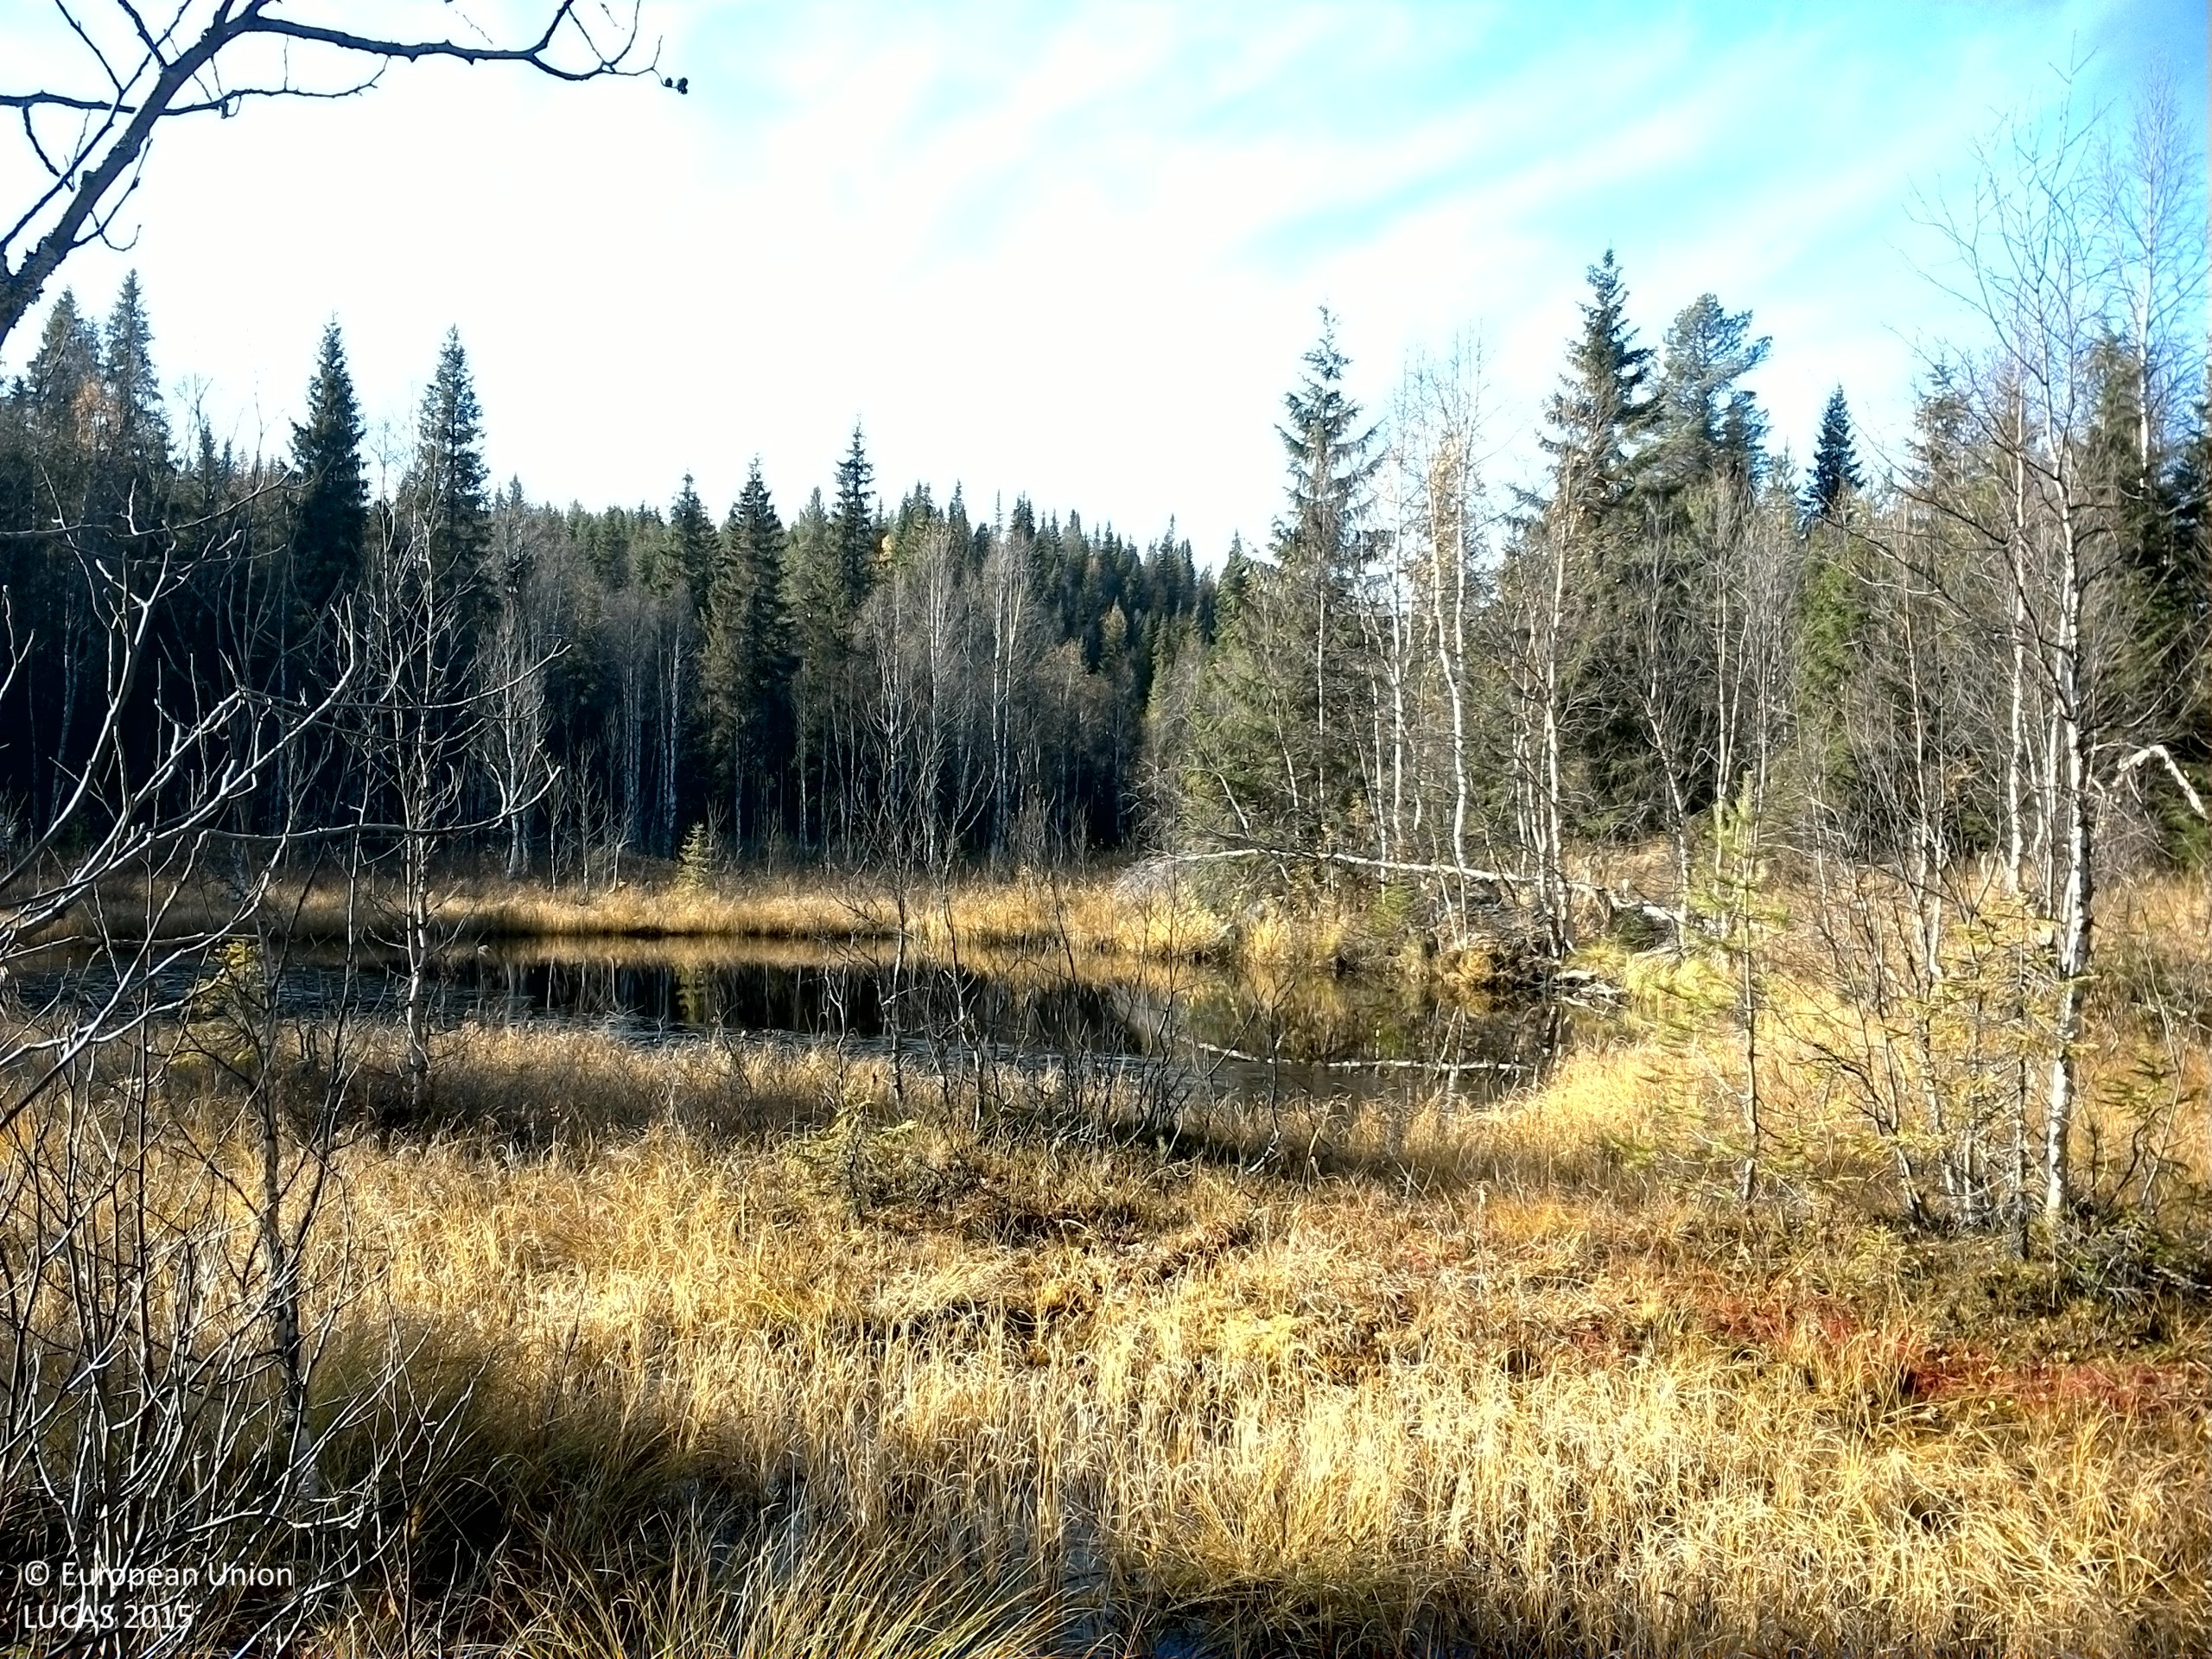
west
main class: Woodland
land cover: Spruce dominated mixed woodland
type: floodplain forest
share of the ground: 25 - 50 %
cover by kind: herbaceous plants 45 %, lichens and mosses 20 %, coniferous forest trees 15 %, broadleaved forest trees 15 %
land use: Semi-natural and natural areas not in use
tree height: < 5 m
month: October
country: SE
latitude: 64.5383
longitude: 15.4946
